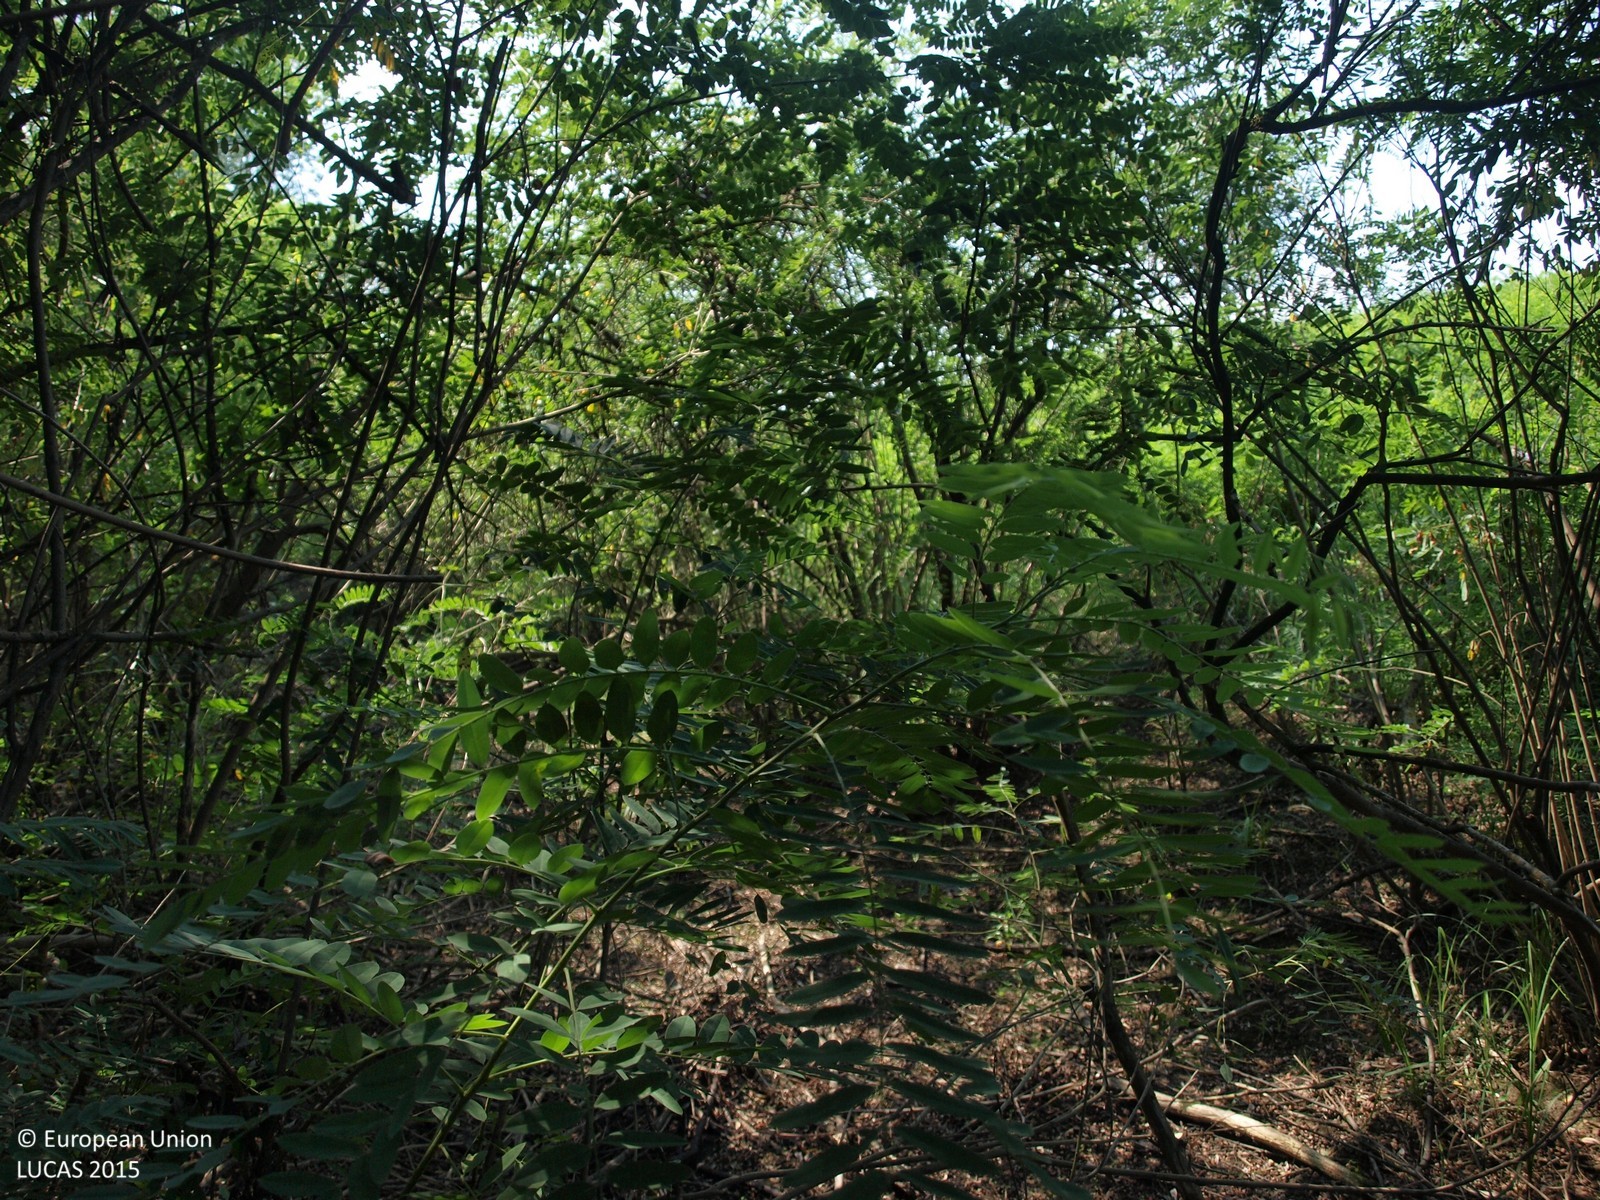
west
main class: Shrubland
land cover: Shrubland with sparse tree cover
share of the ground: > 75 %
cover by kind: shrubs 95 %, broadleaved forest trees 5 %
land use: Semi-natural and natural areas not in use
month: August
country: HR
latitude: 45.8149
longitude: 16.4209
